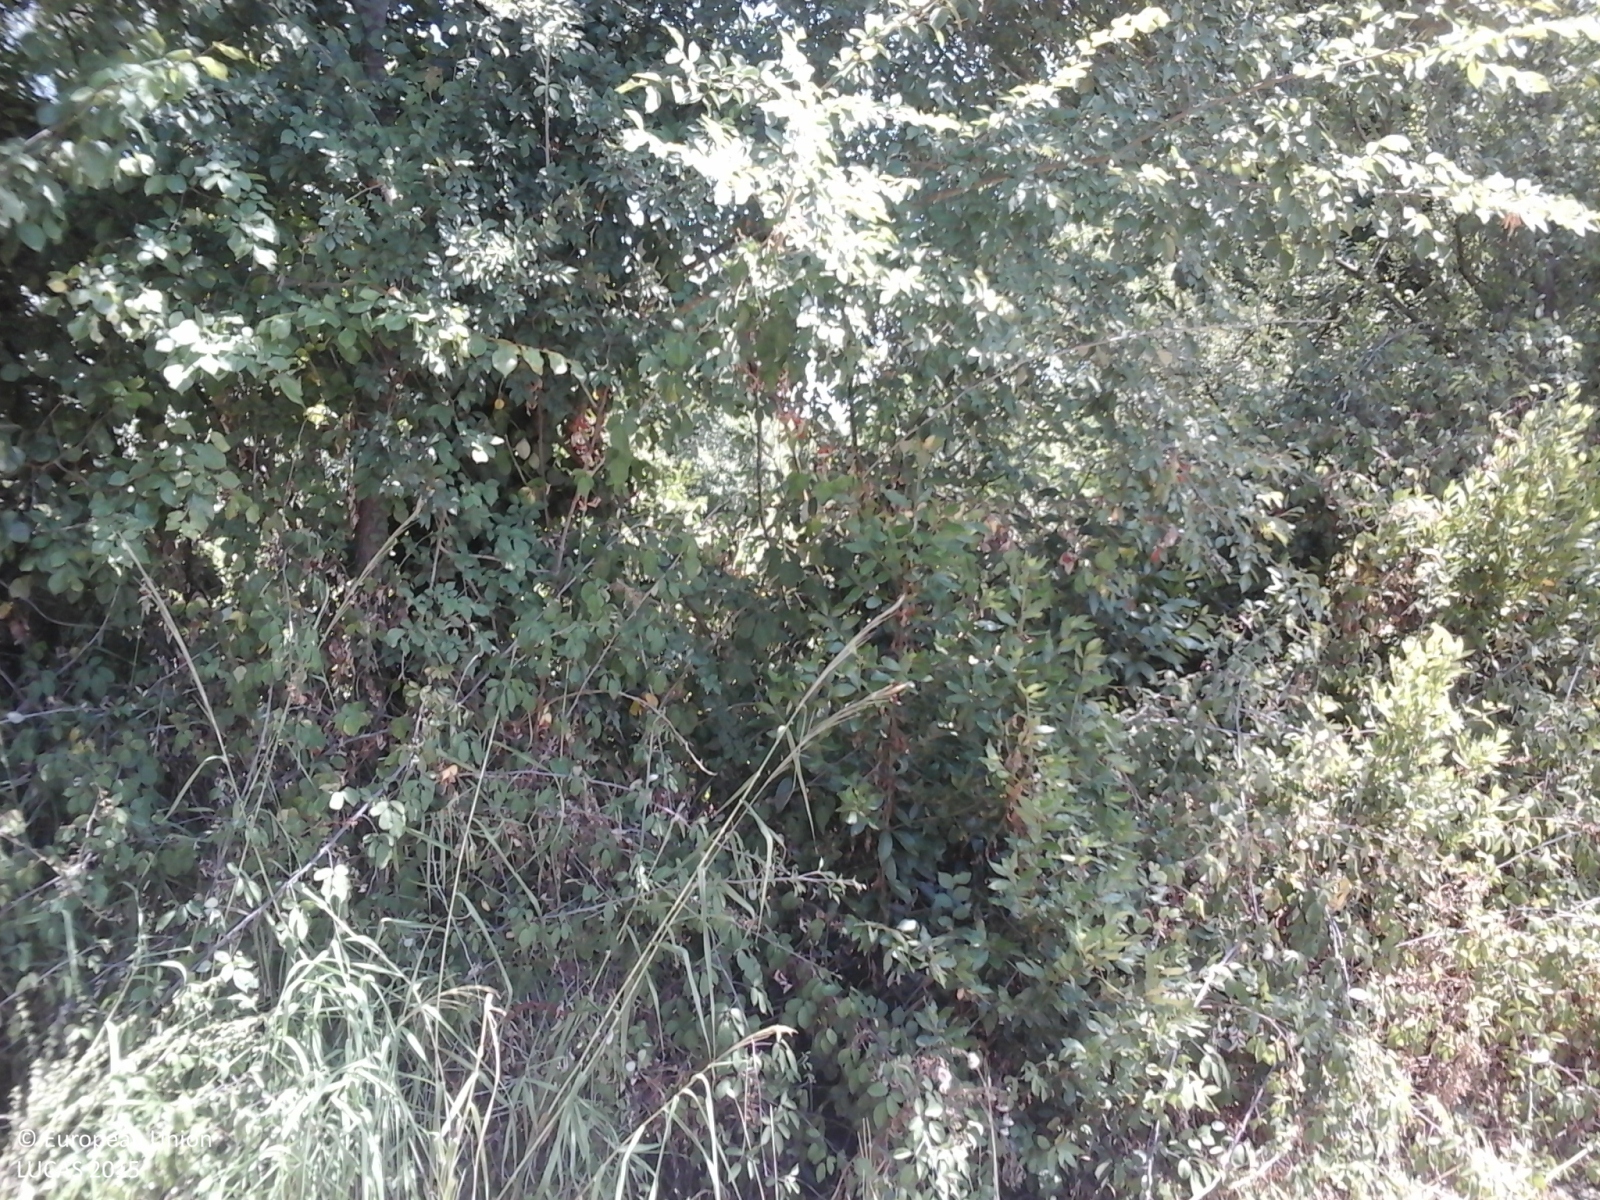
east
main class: Woodland
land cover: Broadleaved woodland
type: thermophilous deciduous forest
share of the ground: > 75 %
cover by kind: broadleaved forest trees 100 %
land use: Semi-natural and natural areas not in use
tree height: > 5 m
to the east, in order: Broadleaved woodland; Ditches and canals; Broadleaved woodland; Lucerne; Broadleaved woodland; Sunflower
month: August
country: IT
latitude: 43.1564
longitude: 13.4220
